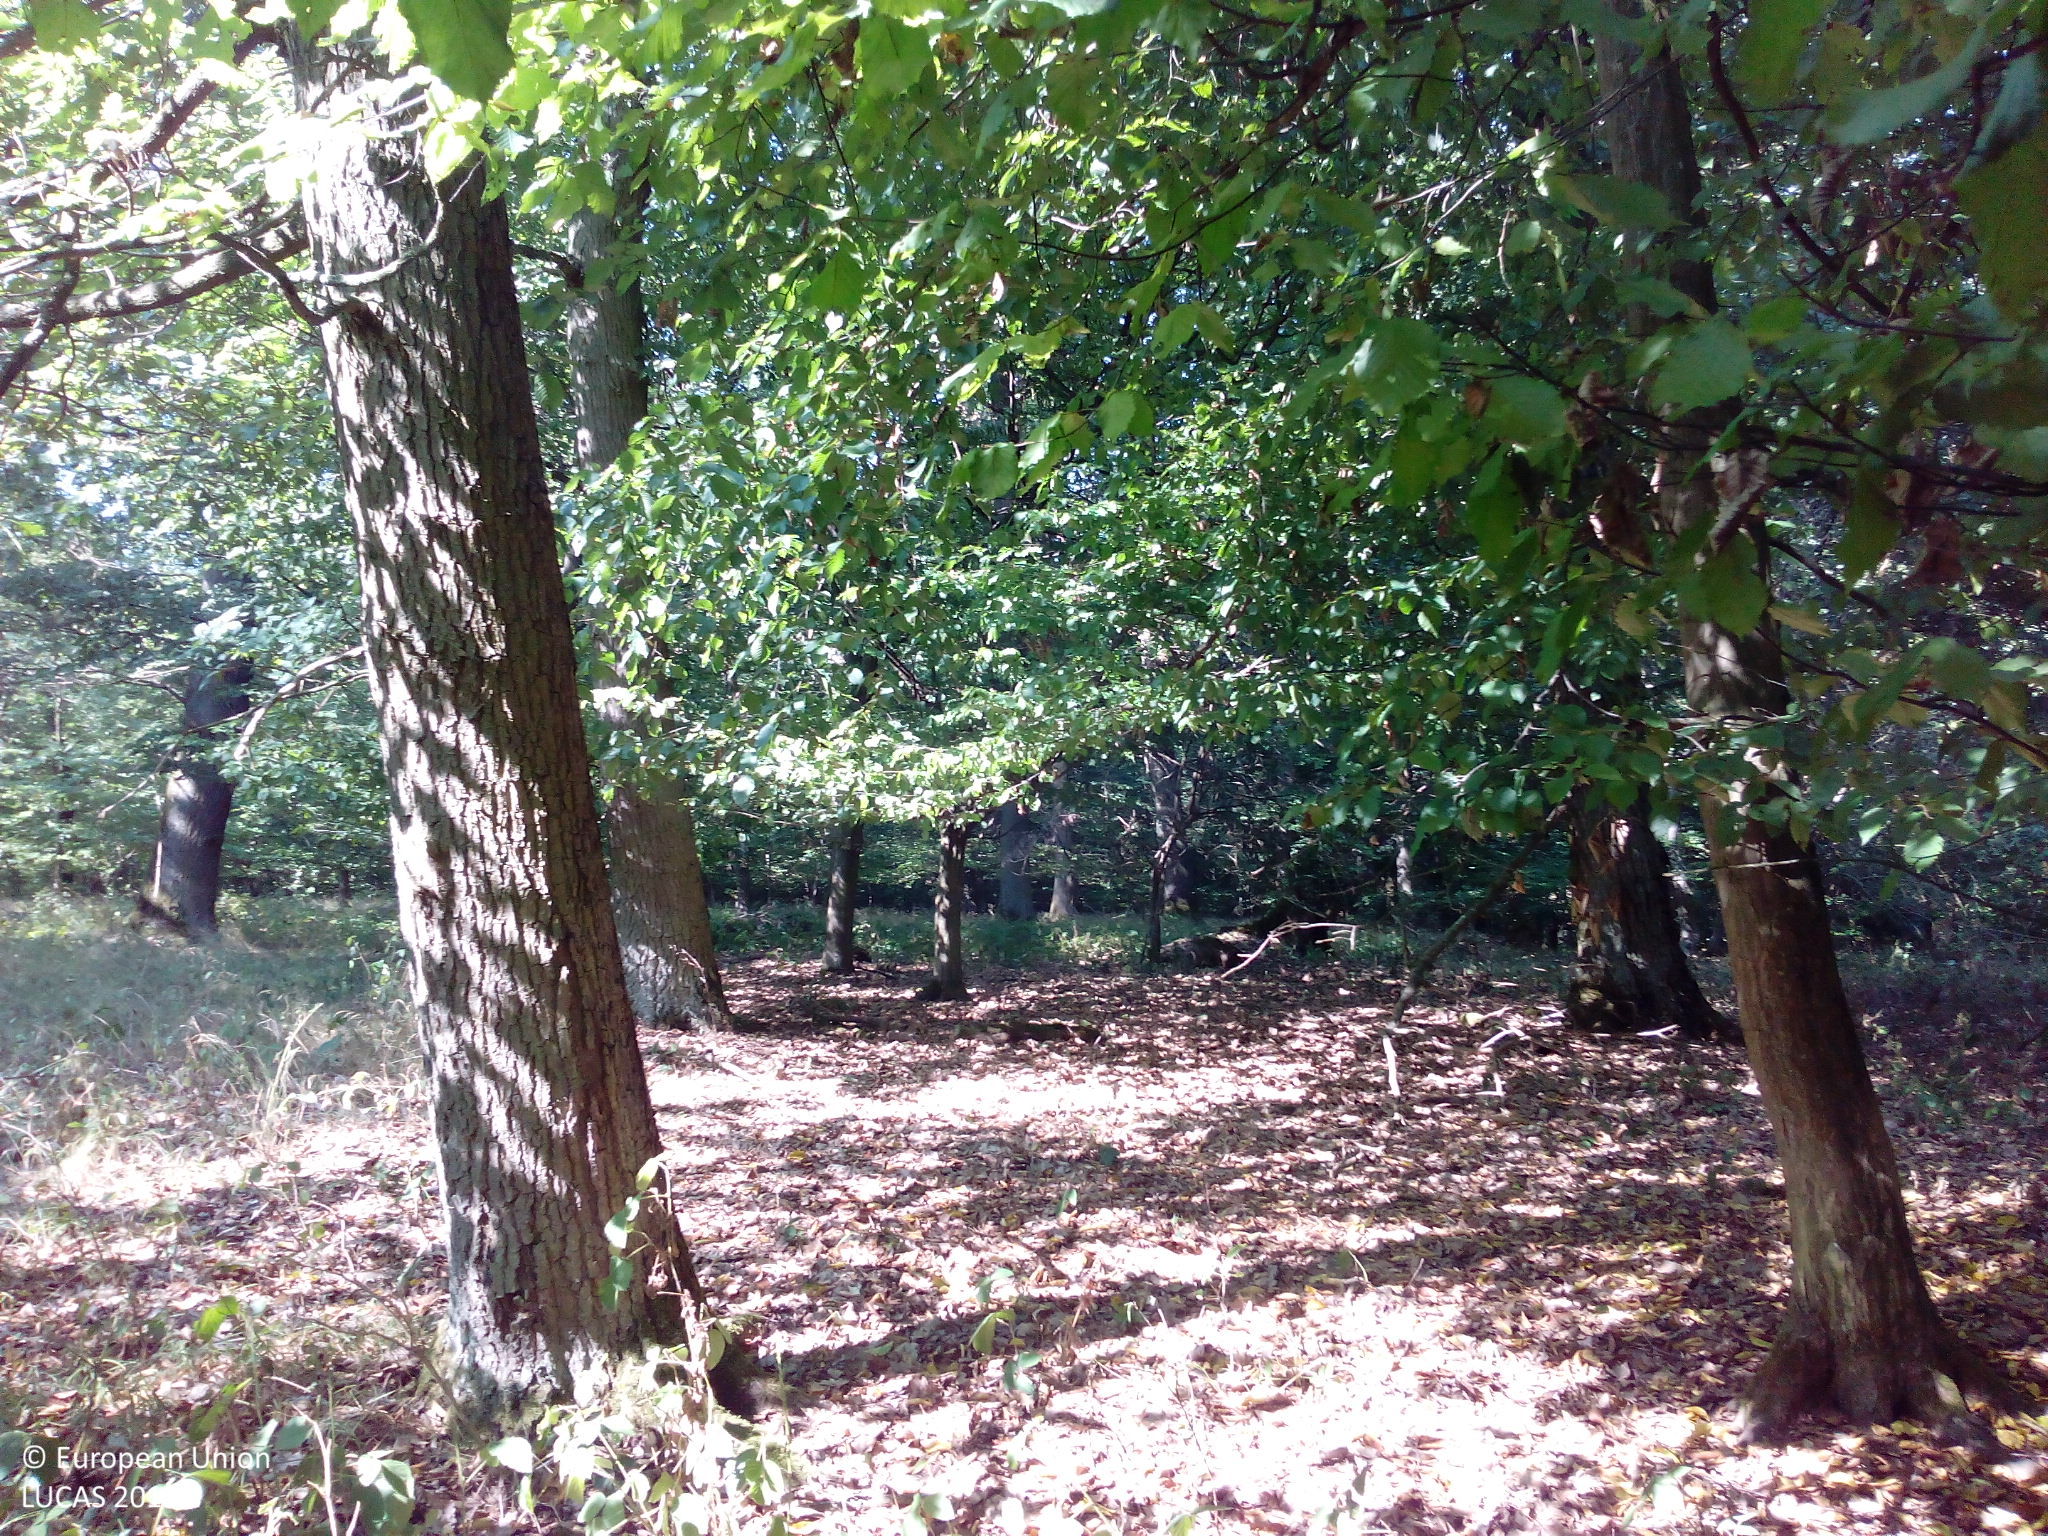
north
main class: Woodland
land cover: Broadleaved woodland
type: mesophytic deciduous forest
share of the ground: > 75 %
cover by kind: broadleaved forest trees 75 %, shrubs 10 %, unconsolidated bare surface 10 %, coniferous forest trees 5 %
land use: Forestry
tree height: > 5 m
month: August
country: DE
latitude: 50.1741
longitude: 7.4659
